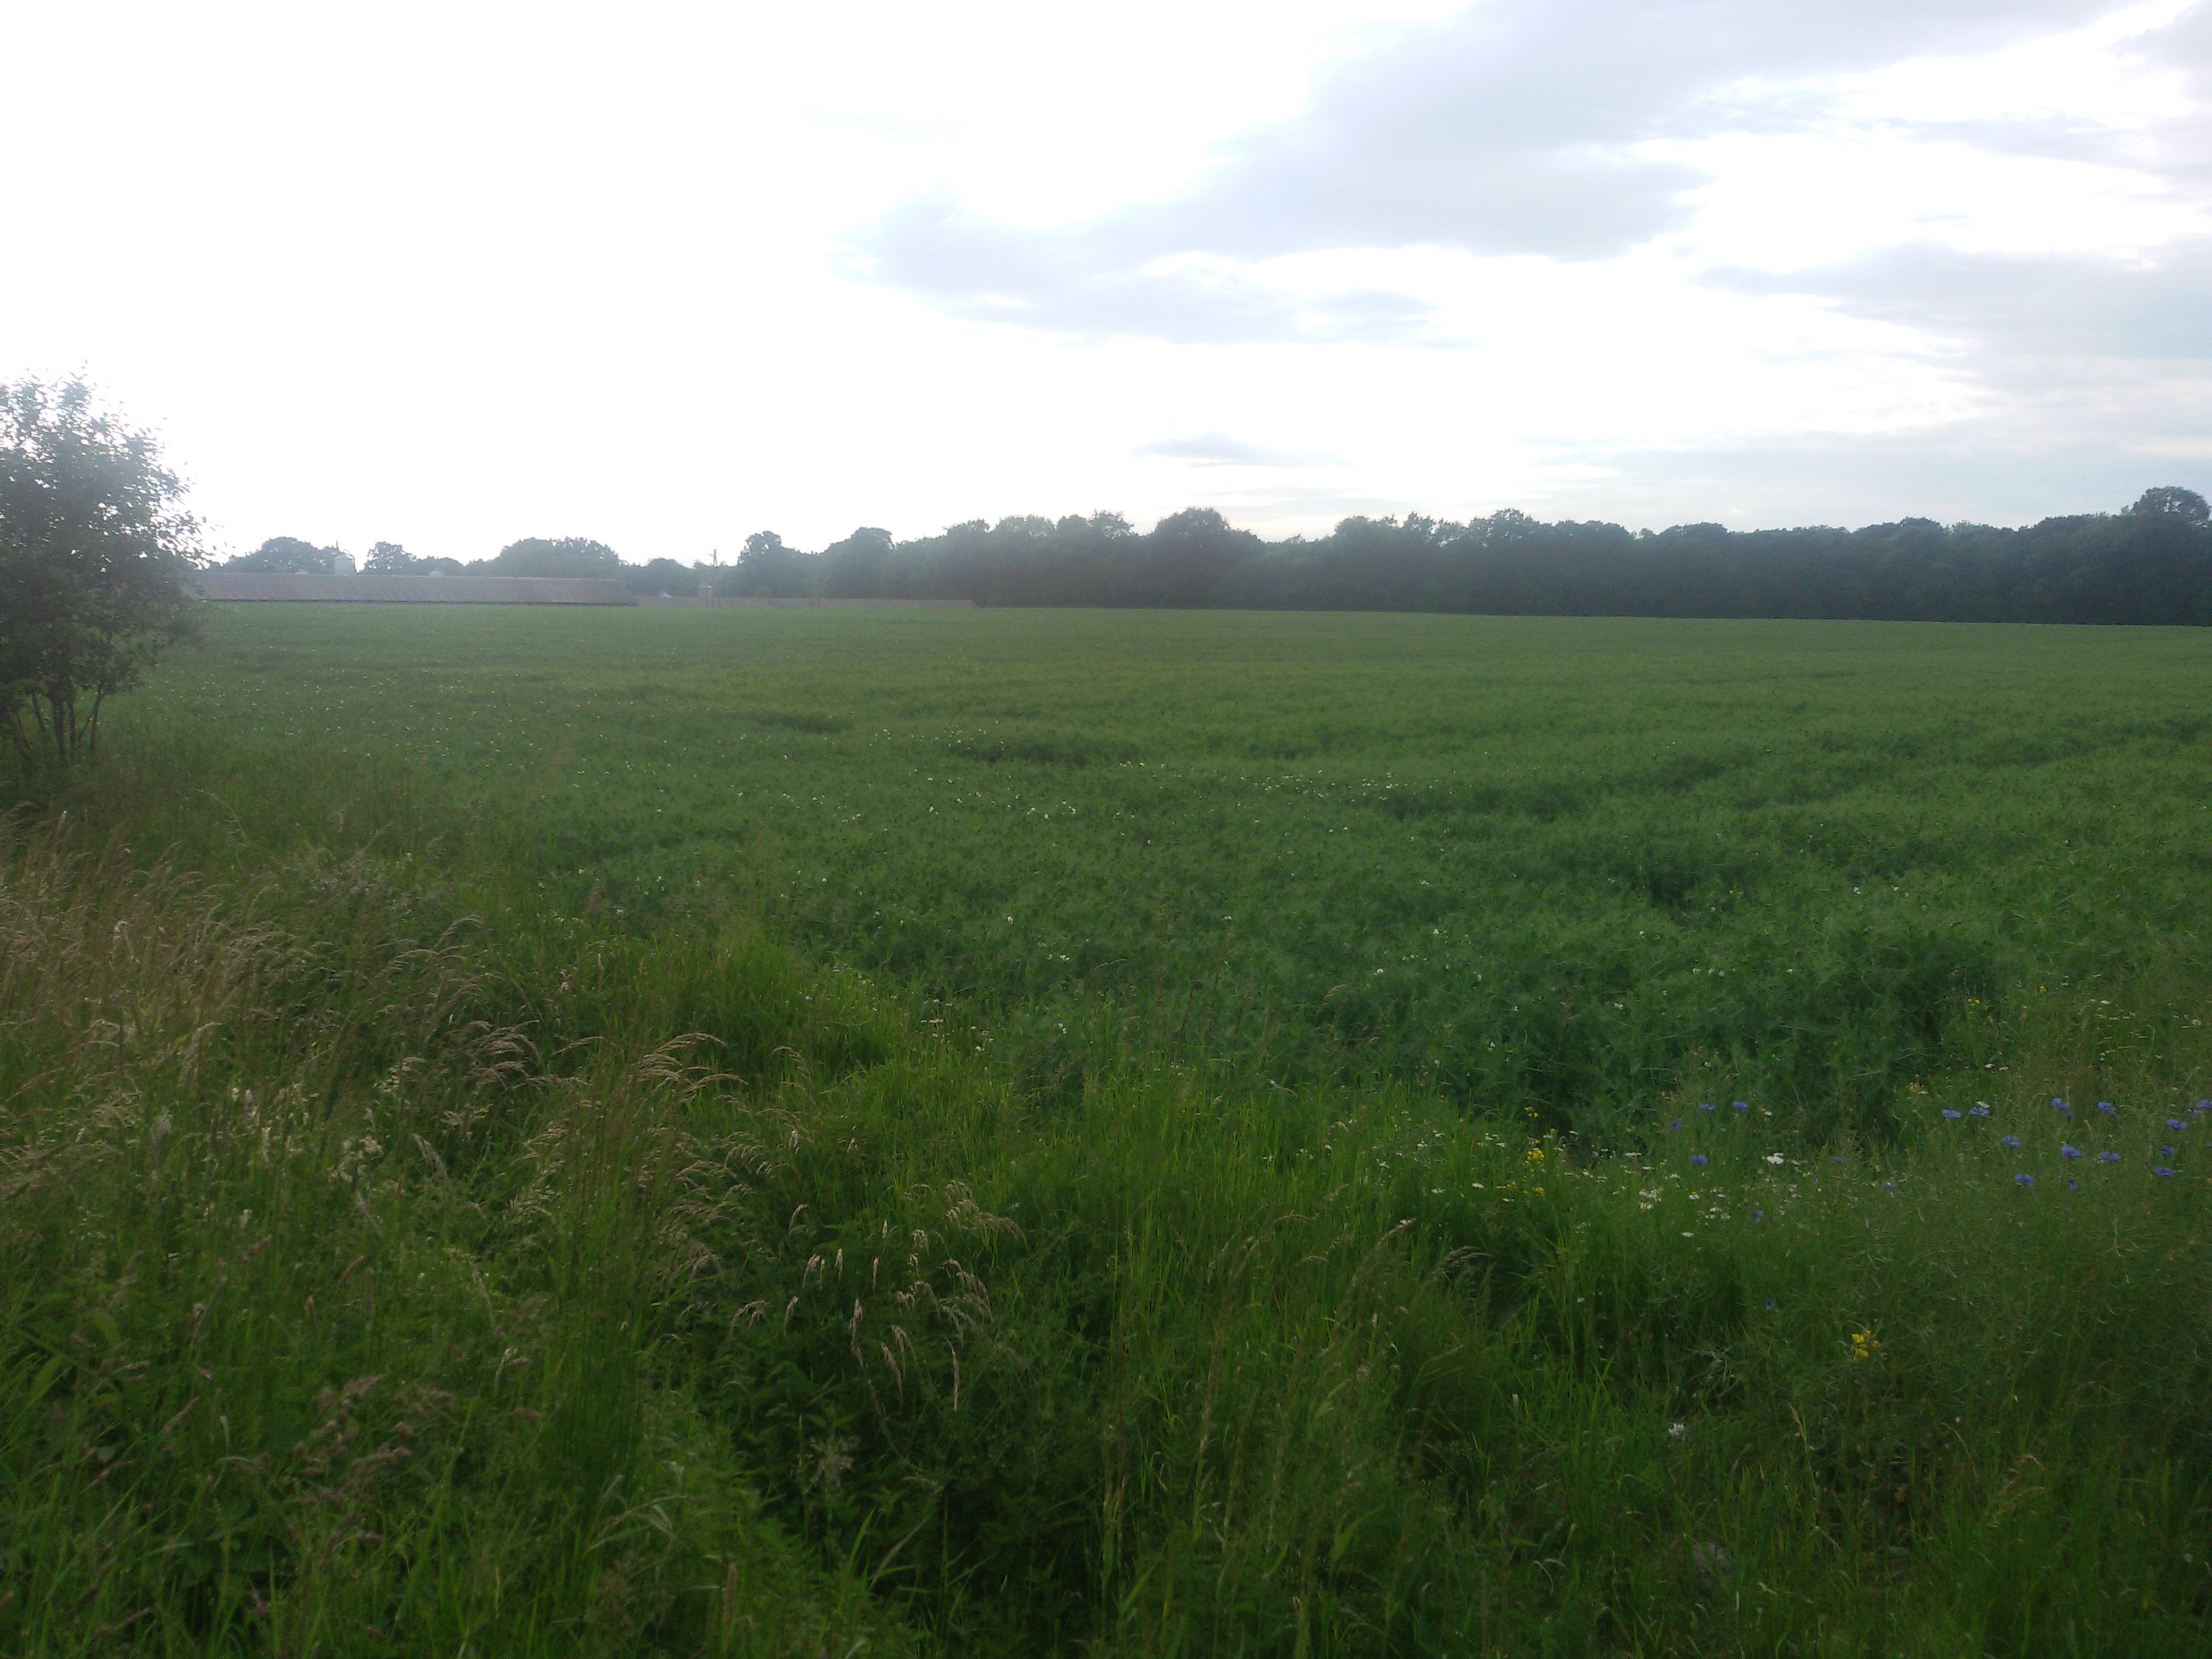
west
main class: Cropland
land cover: Rape and turnip rape
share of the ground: > 75 %
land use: Agriculture (excluding fallow land and kitchen gardens)
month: June
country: PL
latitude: 50.5056
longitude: 17.6416
